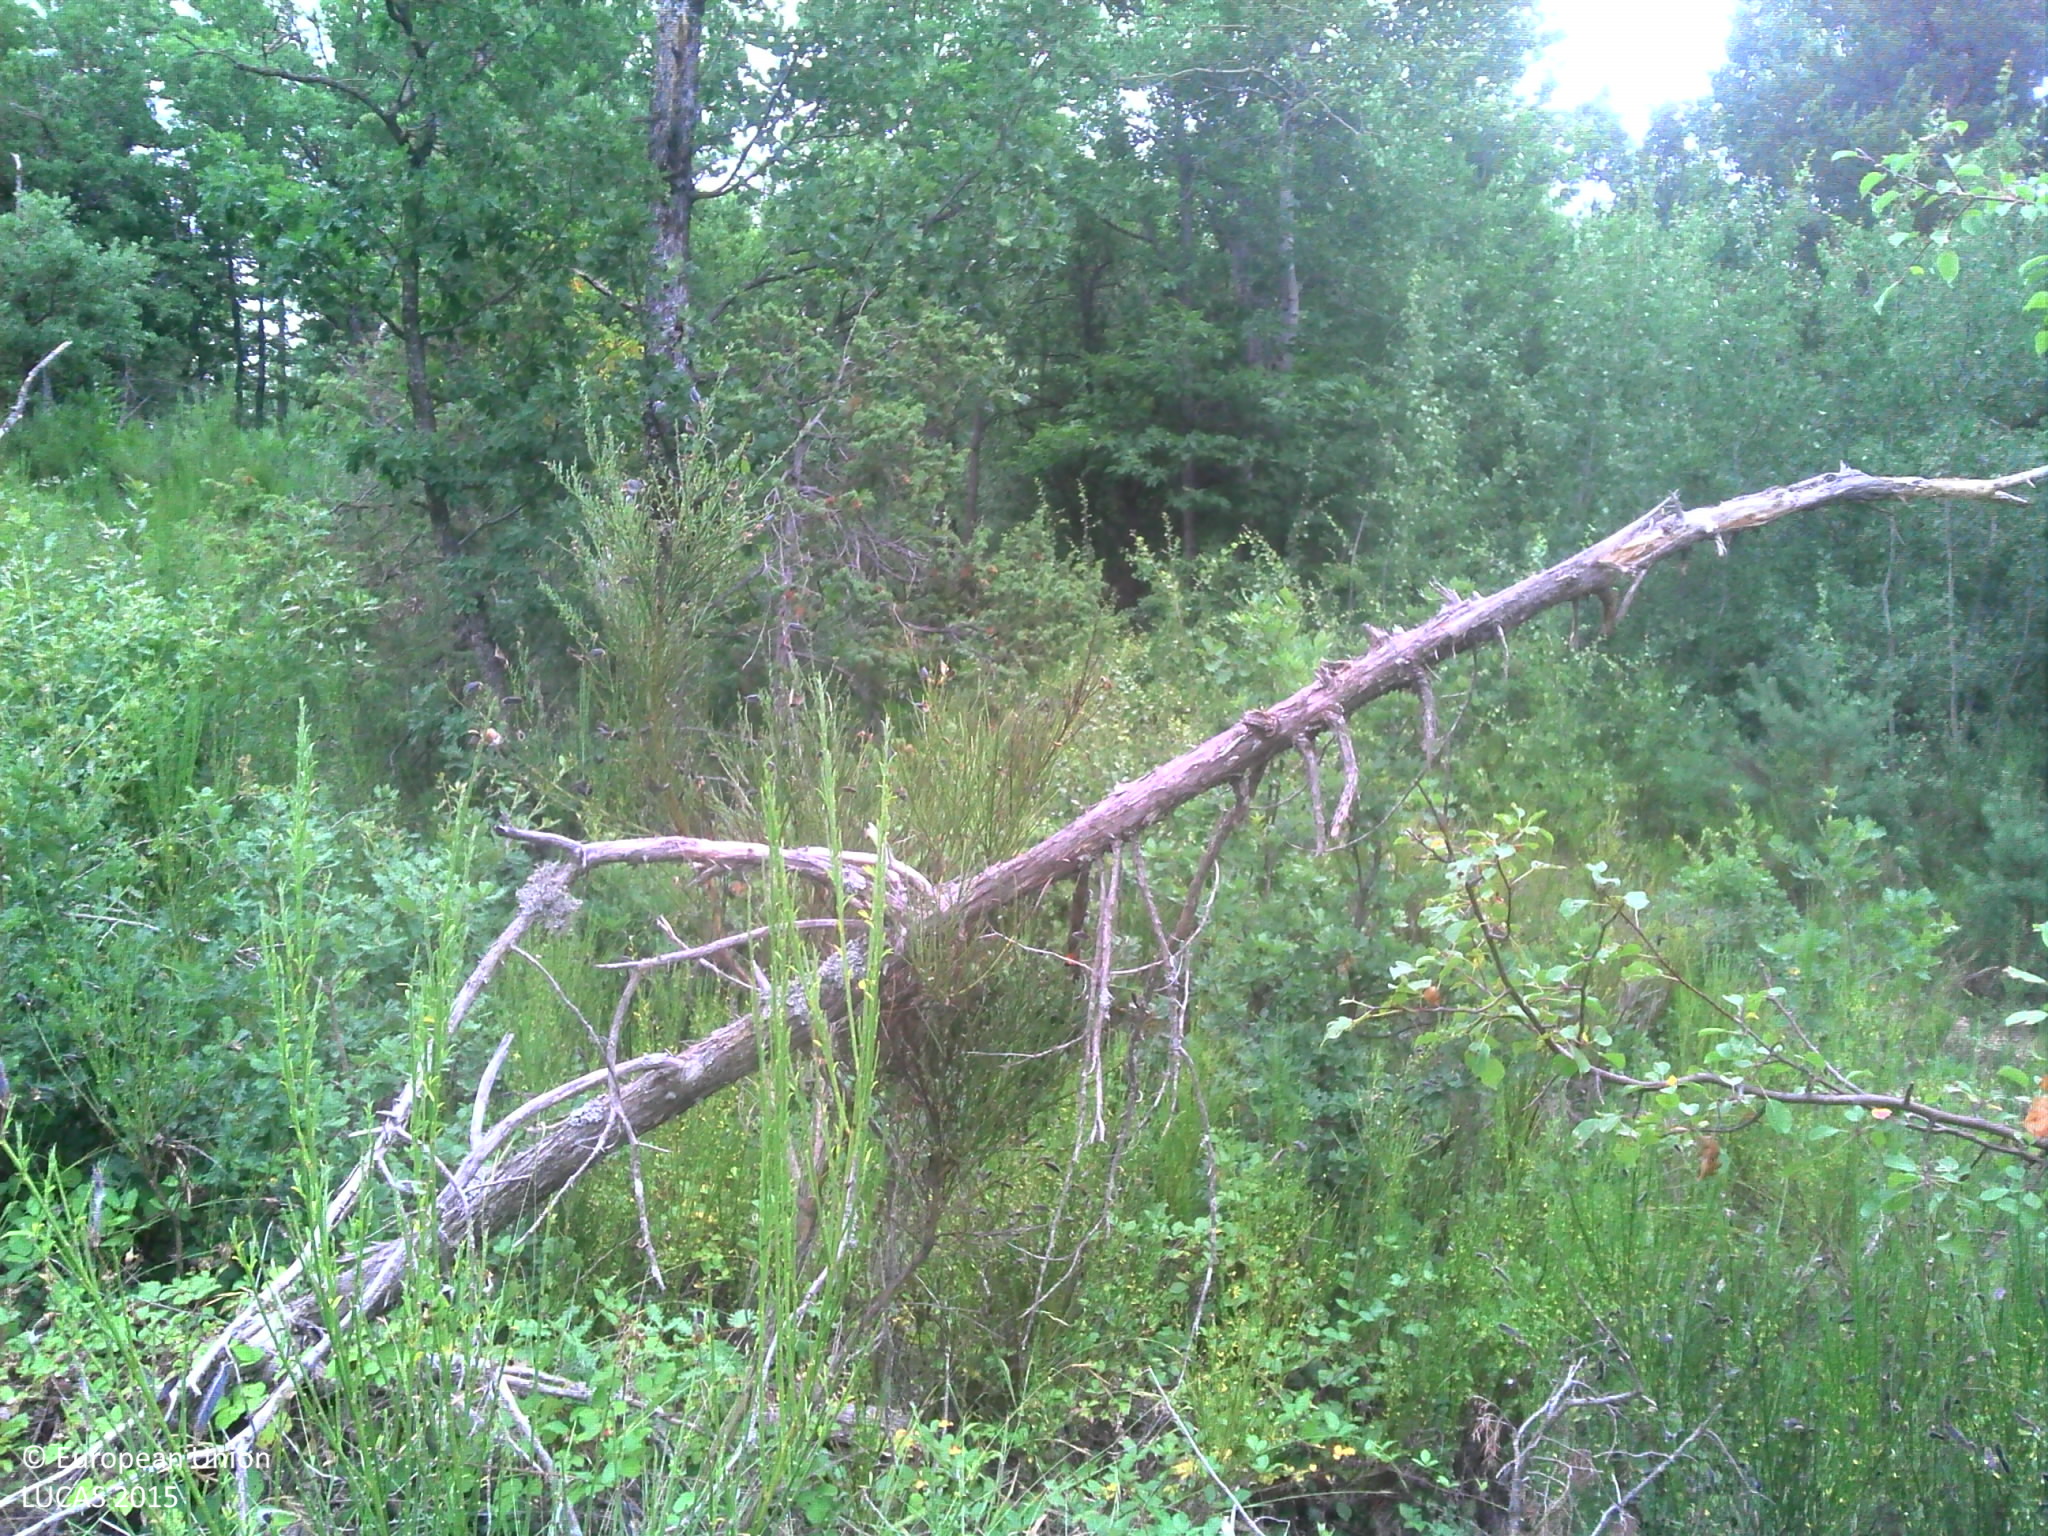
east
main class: Woodland
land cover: Broadleaved woodland
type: thermophilous deciduous forest
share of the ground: 25 - 50 %
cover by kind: broadleaved forest trees 40 %, herbaceous plants 35 %, shrubs 20 %, consolidated bare surface 5 %
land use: Forestry
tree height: > 5 m
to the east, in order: Broadleaved woodland; Fences; Shrubland with sparse tree cover; Fences; Electric lines; Grass margins; Tracks; Pine dominated mixed woodland; Broadleaved woodland; Pine dominated mixed woodland
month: July
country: FR
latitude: 44.1105
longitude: 5.5476
